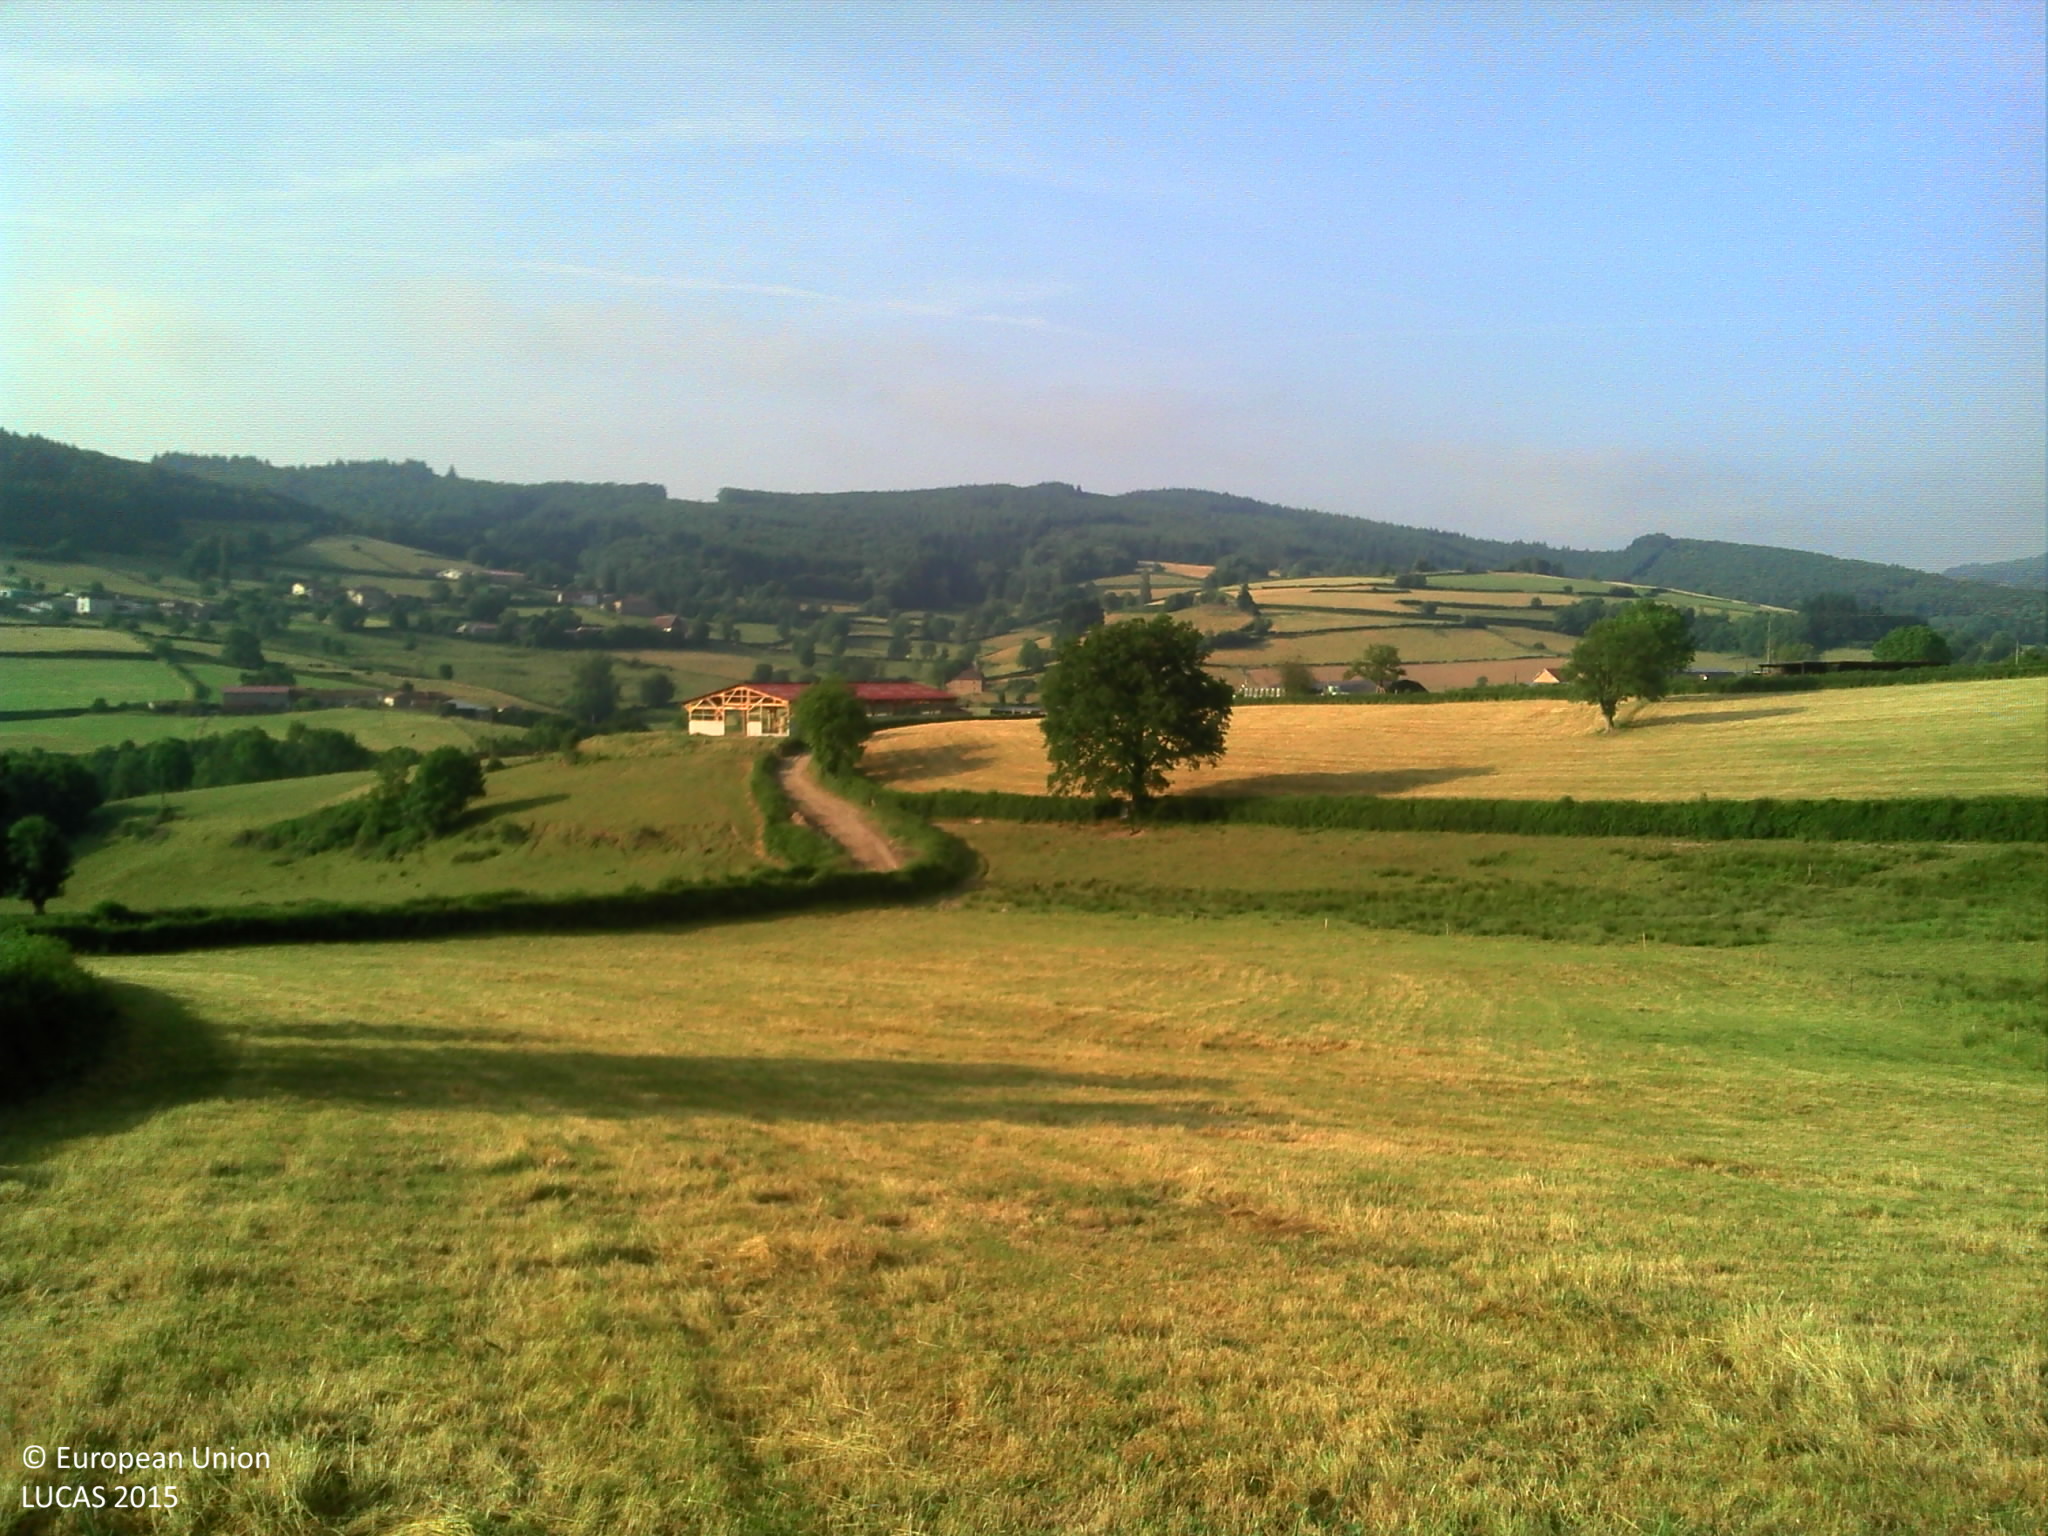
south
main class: Grassland
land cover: Grassland without tree/shrub cover
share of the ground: > 75 %
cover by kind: herbaceous plants 100 %
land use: Agriculture (excluding fallow land and kitchen gardens)
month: June
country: FR
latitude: 46.3184
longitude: 4.5082
